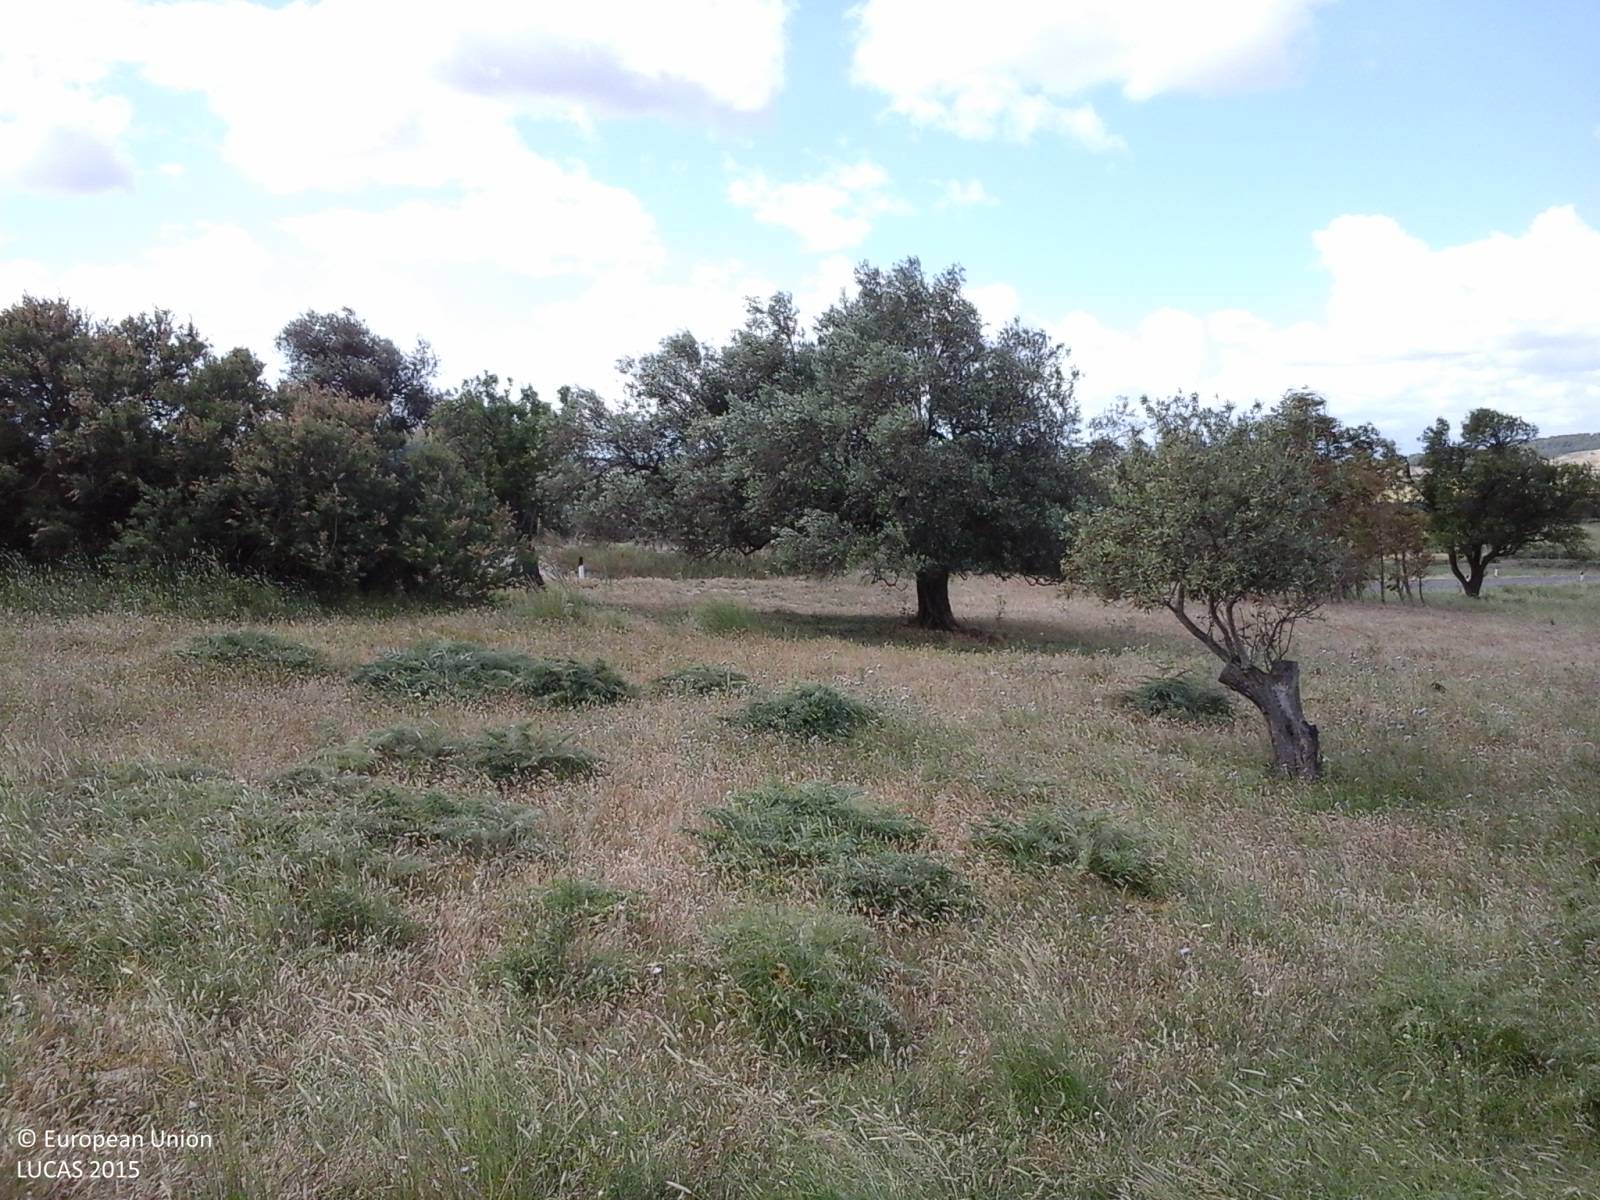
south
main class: Grassland
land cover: Spontaneously vegetated surfaces
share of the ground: > 75 %
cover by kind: herbaceous plants 95 %, shrubs 5 %
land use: Agriculture (excluding fallow land and kitchen gardens)
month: May
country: IT
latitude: 39.7541
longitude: 8.8975
